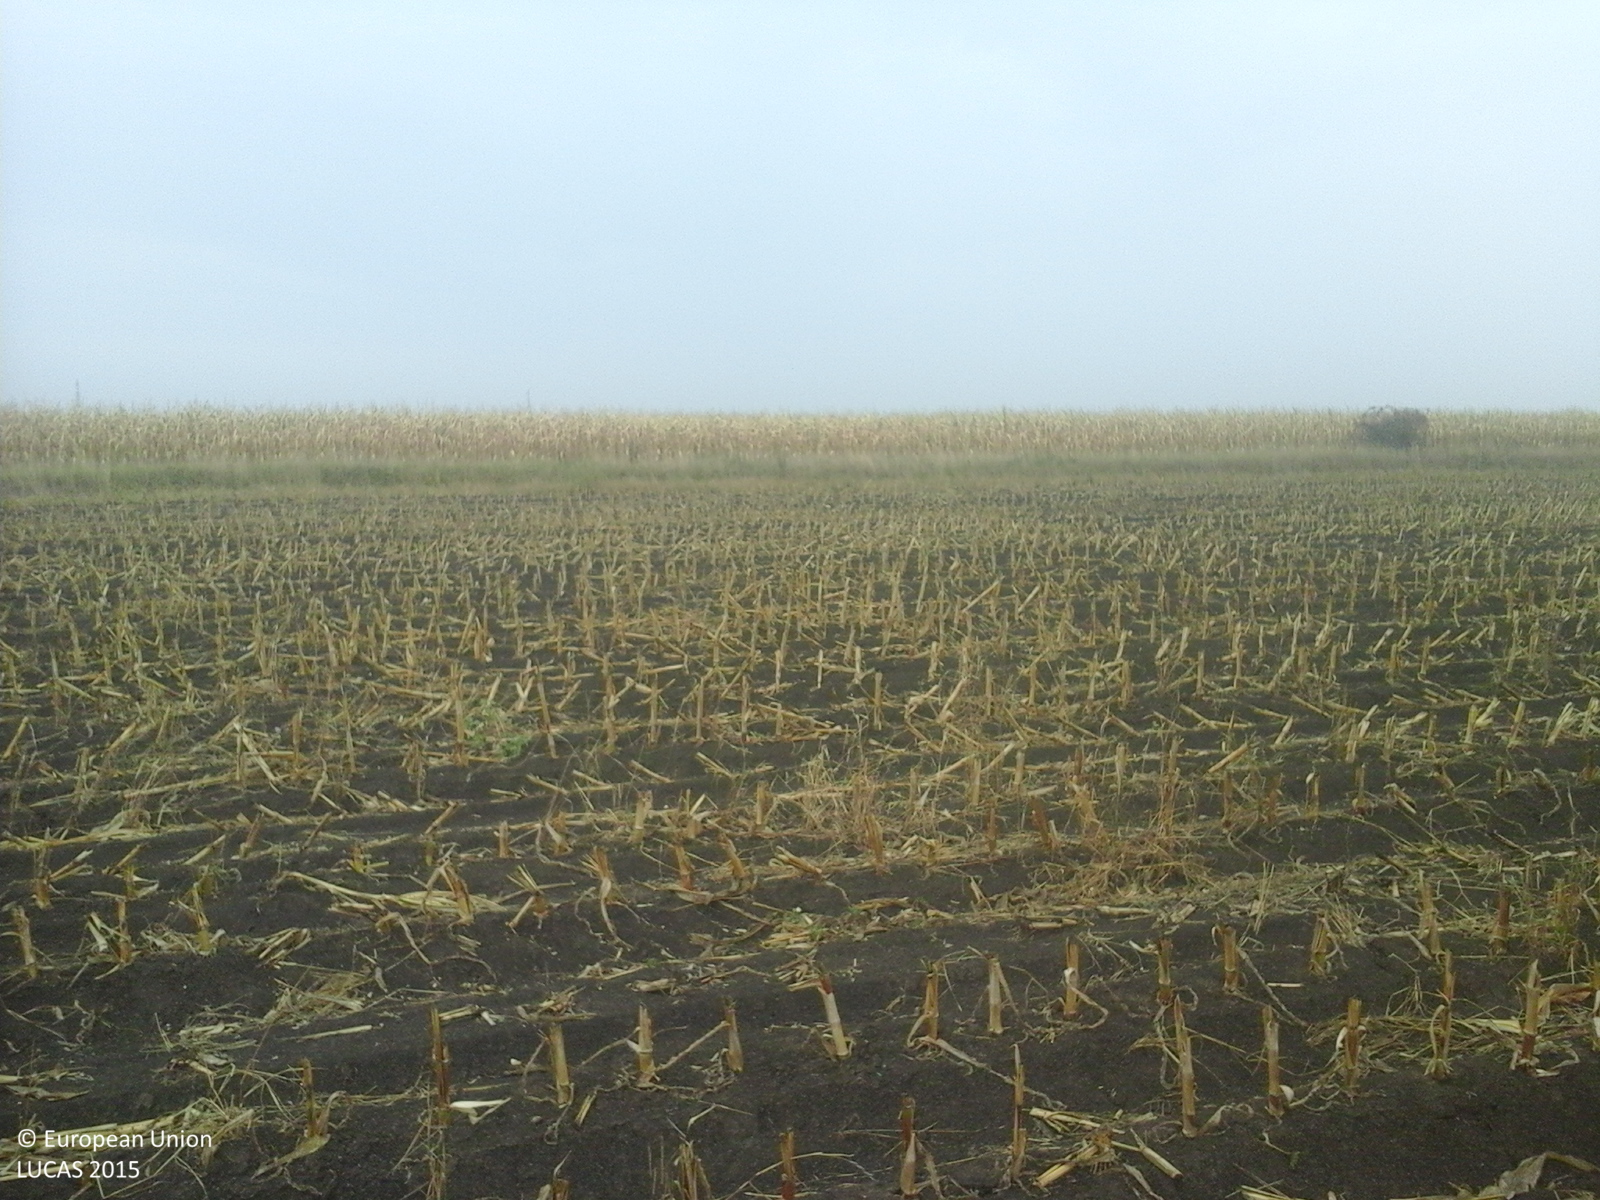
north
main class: Cropland
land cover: Maize
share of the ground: > 75 %
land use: Agriculture (excluding fallow land and kitchen gardens)
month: September
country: RO
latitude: 47.7007
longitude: 22.5722
